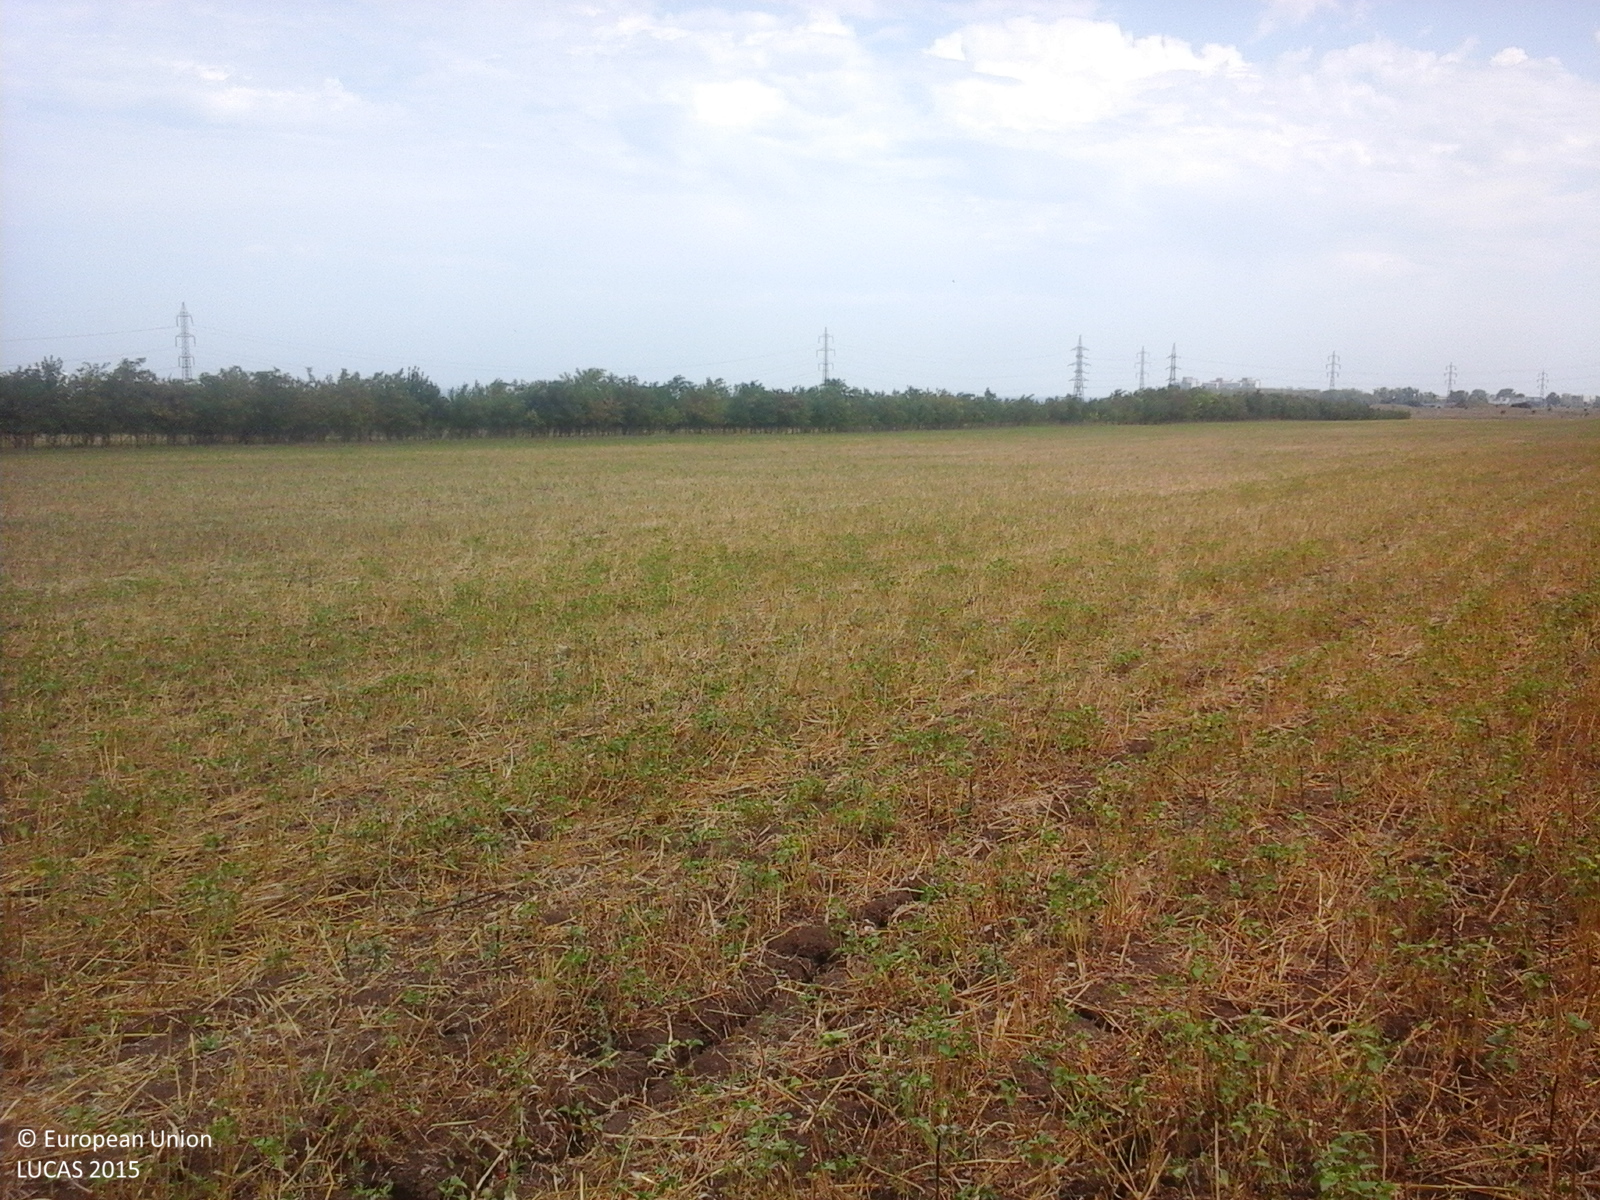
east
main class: Cropland
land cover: Oats
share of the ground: 25 - 50 %
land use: Agriculture (excluding fallow land and kitchen gardens)
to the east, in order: Oats; Groves; Oats
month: August
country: RO
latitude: 43.8397
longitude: 28.5624
